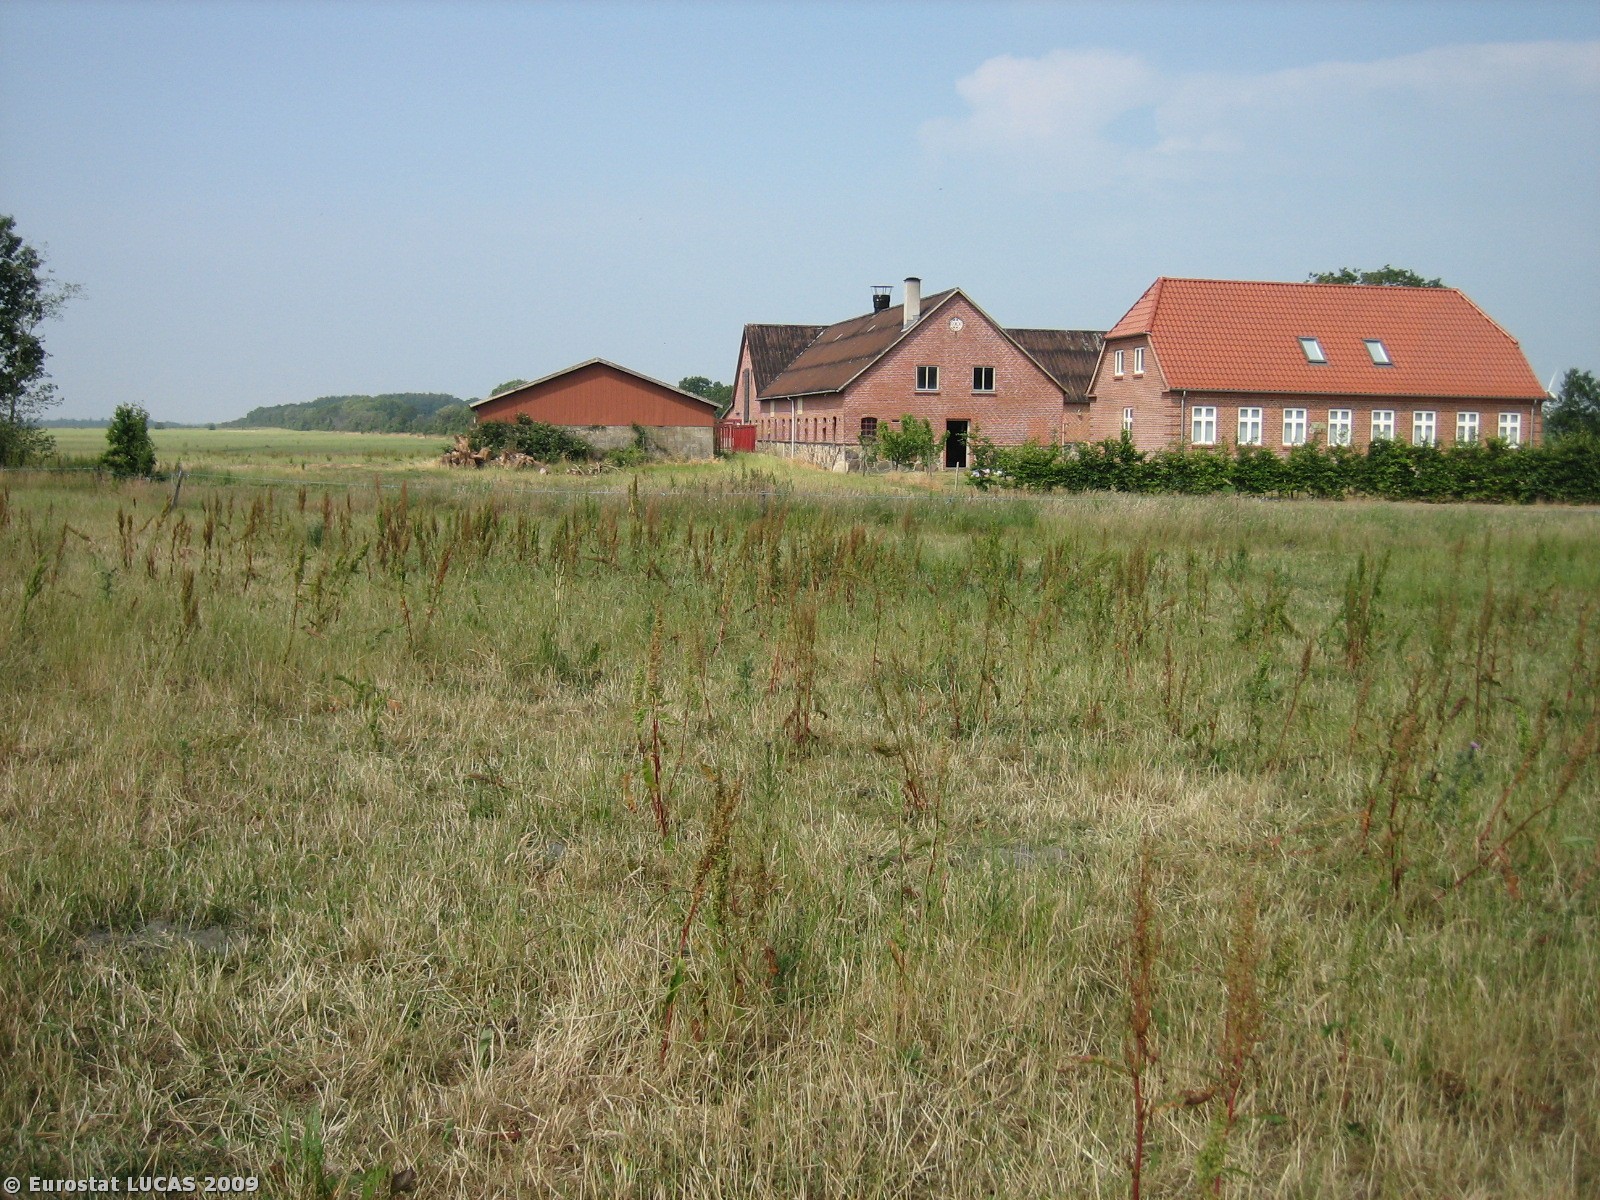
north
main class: Grassland
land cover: Grassland without tree/shrub cover
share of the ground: > 75 %
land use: Agriculture (excluding fallow land and kitchen gardens)
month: July
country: DK
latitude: 55.5710
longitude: 8.8117
